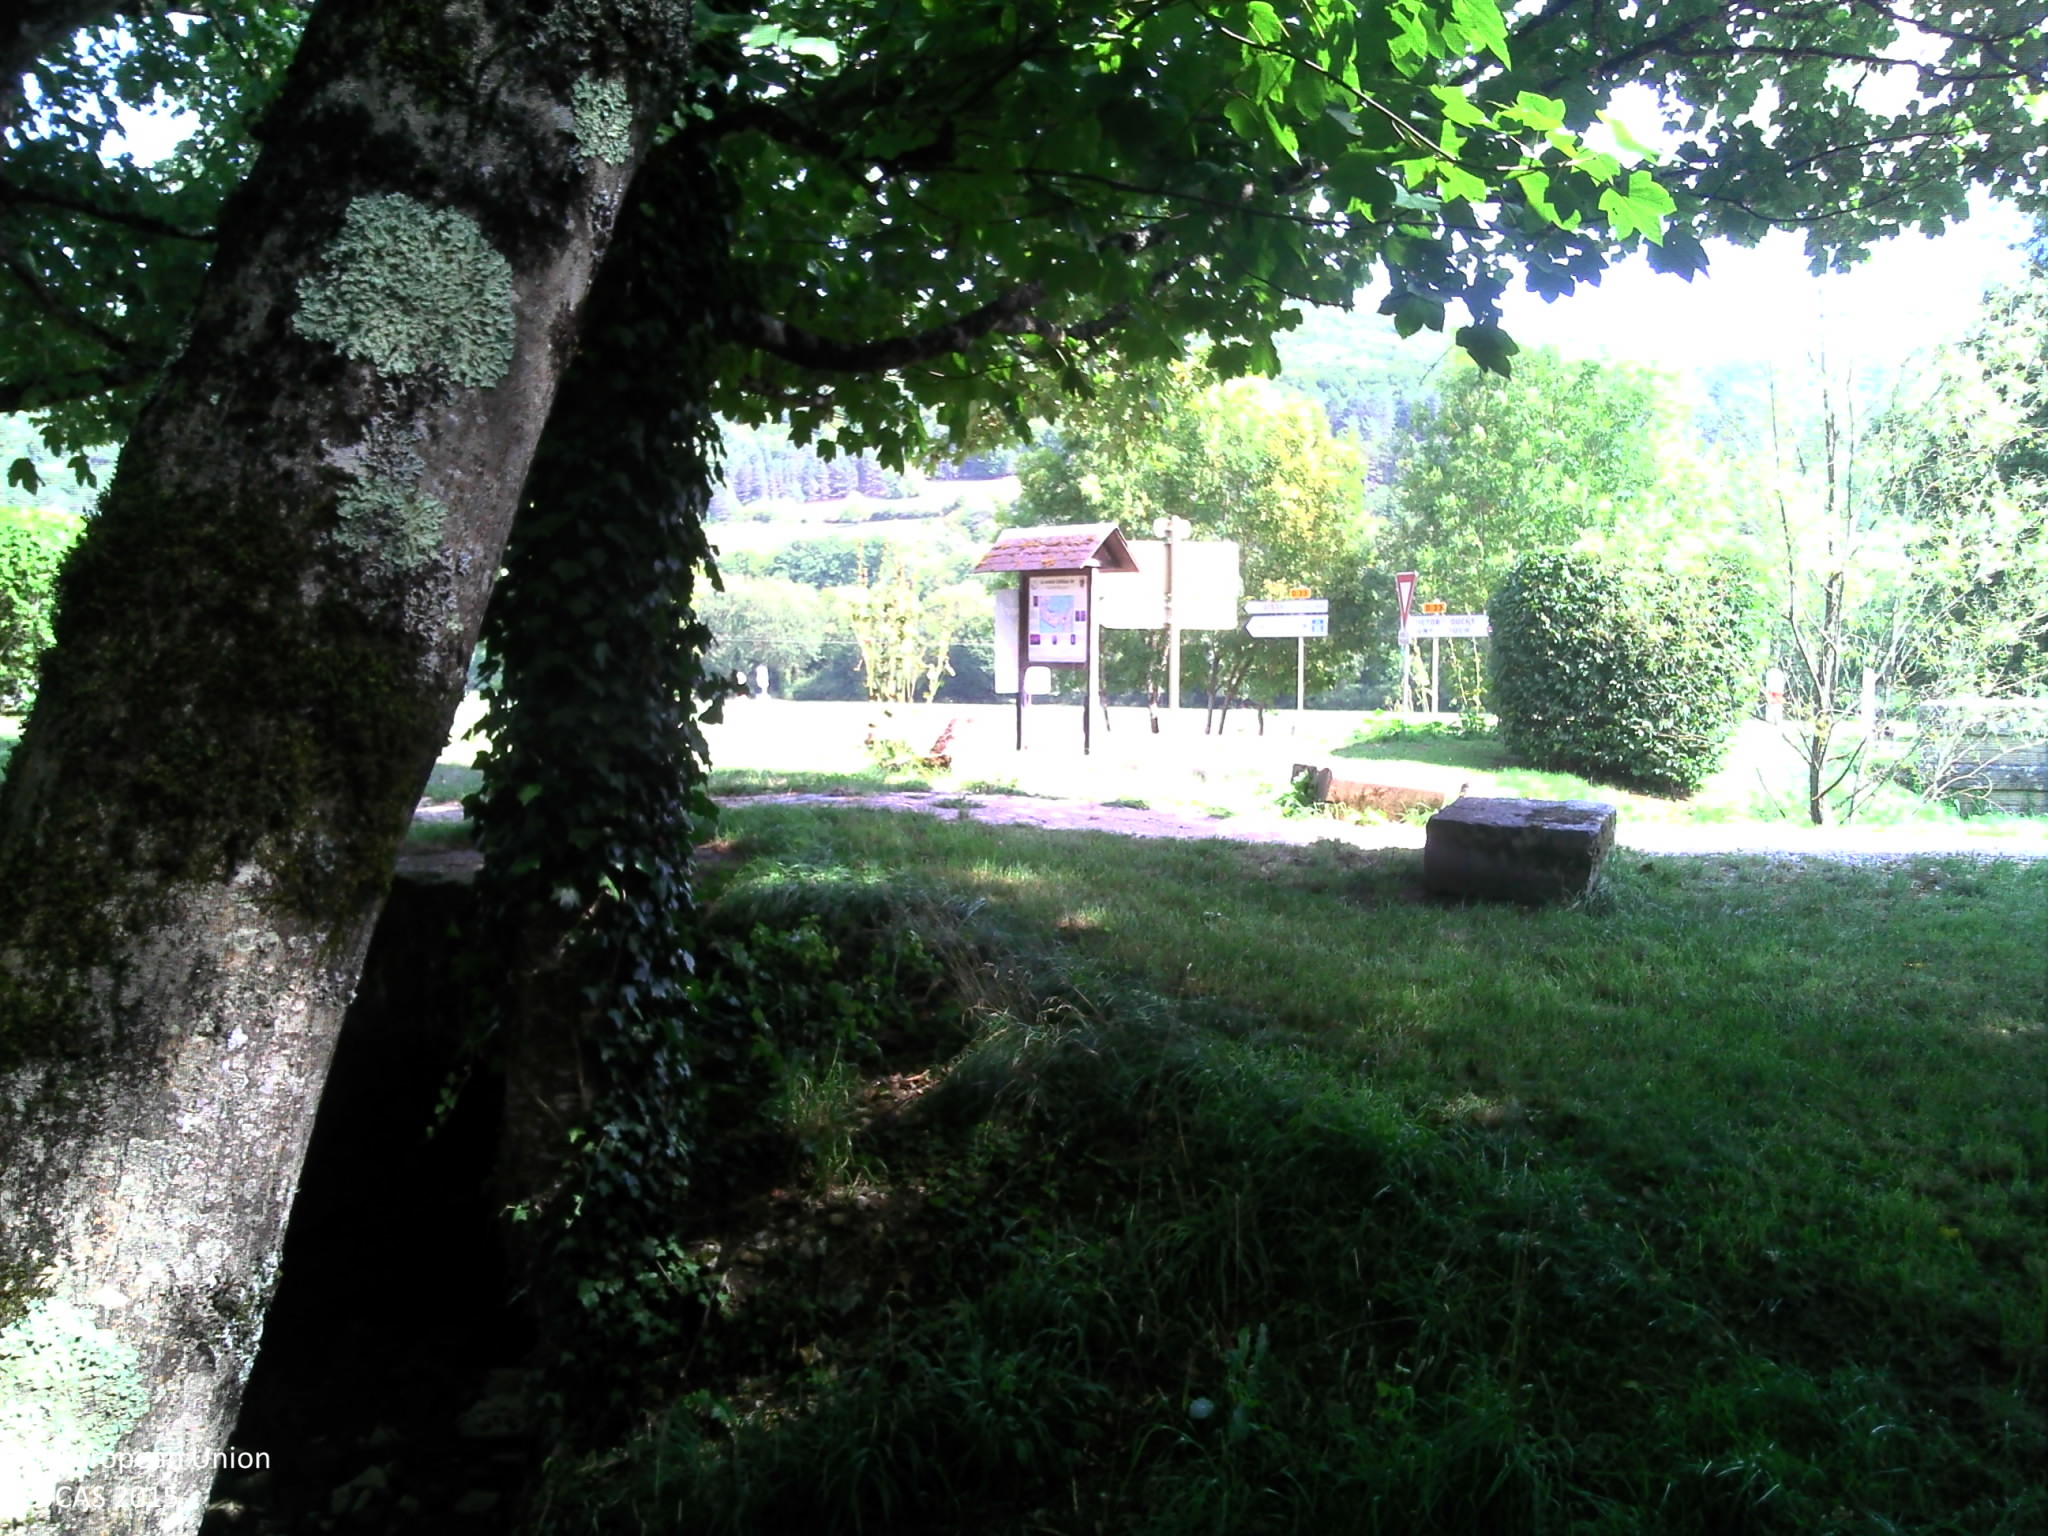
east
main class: Grassland
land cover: Grassland without tree/shrub cover
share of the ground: > 75 %
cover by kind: herbaceous plants 100 %
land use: Agriculture (excluding fallow land and kitchen gardens)
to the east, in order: Grassland without tree/shrub cover; Broadleaved woodland; Grassland without tree/shrub cover; Dry stone walls; Broadleaved woodland; Rivers and streams; Broadleaved woodland; Tracks; Grassland with sparse tree/shrub cover; Paved roads, cycling and walking lanes; Other bare soil; Grassland without tree/shrub cover; Paved roads, cycling and walking lanes; Grass margins; Dry stone walls; Fences; Single bushes/trees; Grassland without tree/shrub cover; Fences; Grassland without tree/shrub cover; Electric lines; Grassland without tree/shrub cover
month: August
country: FR
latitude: 47.2510
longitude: 4.7546
